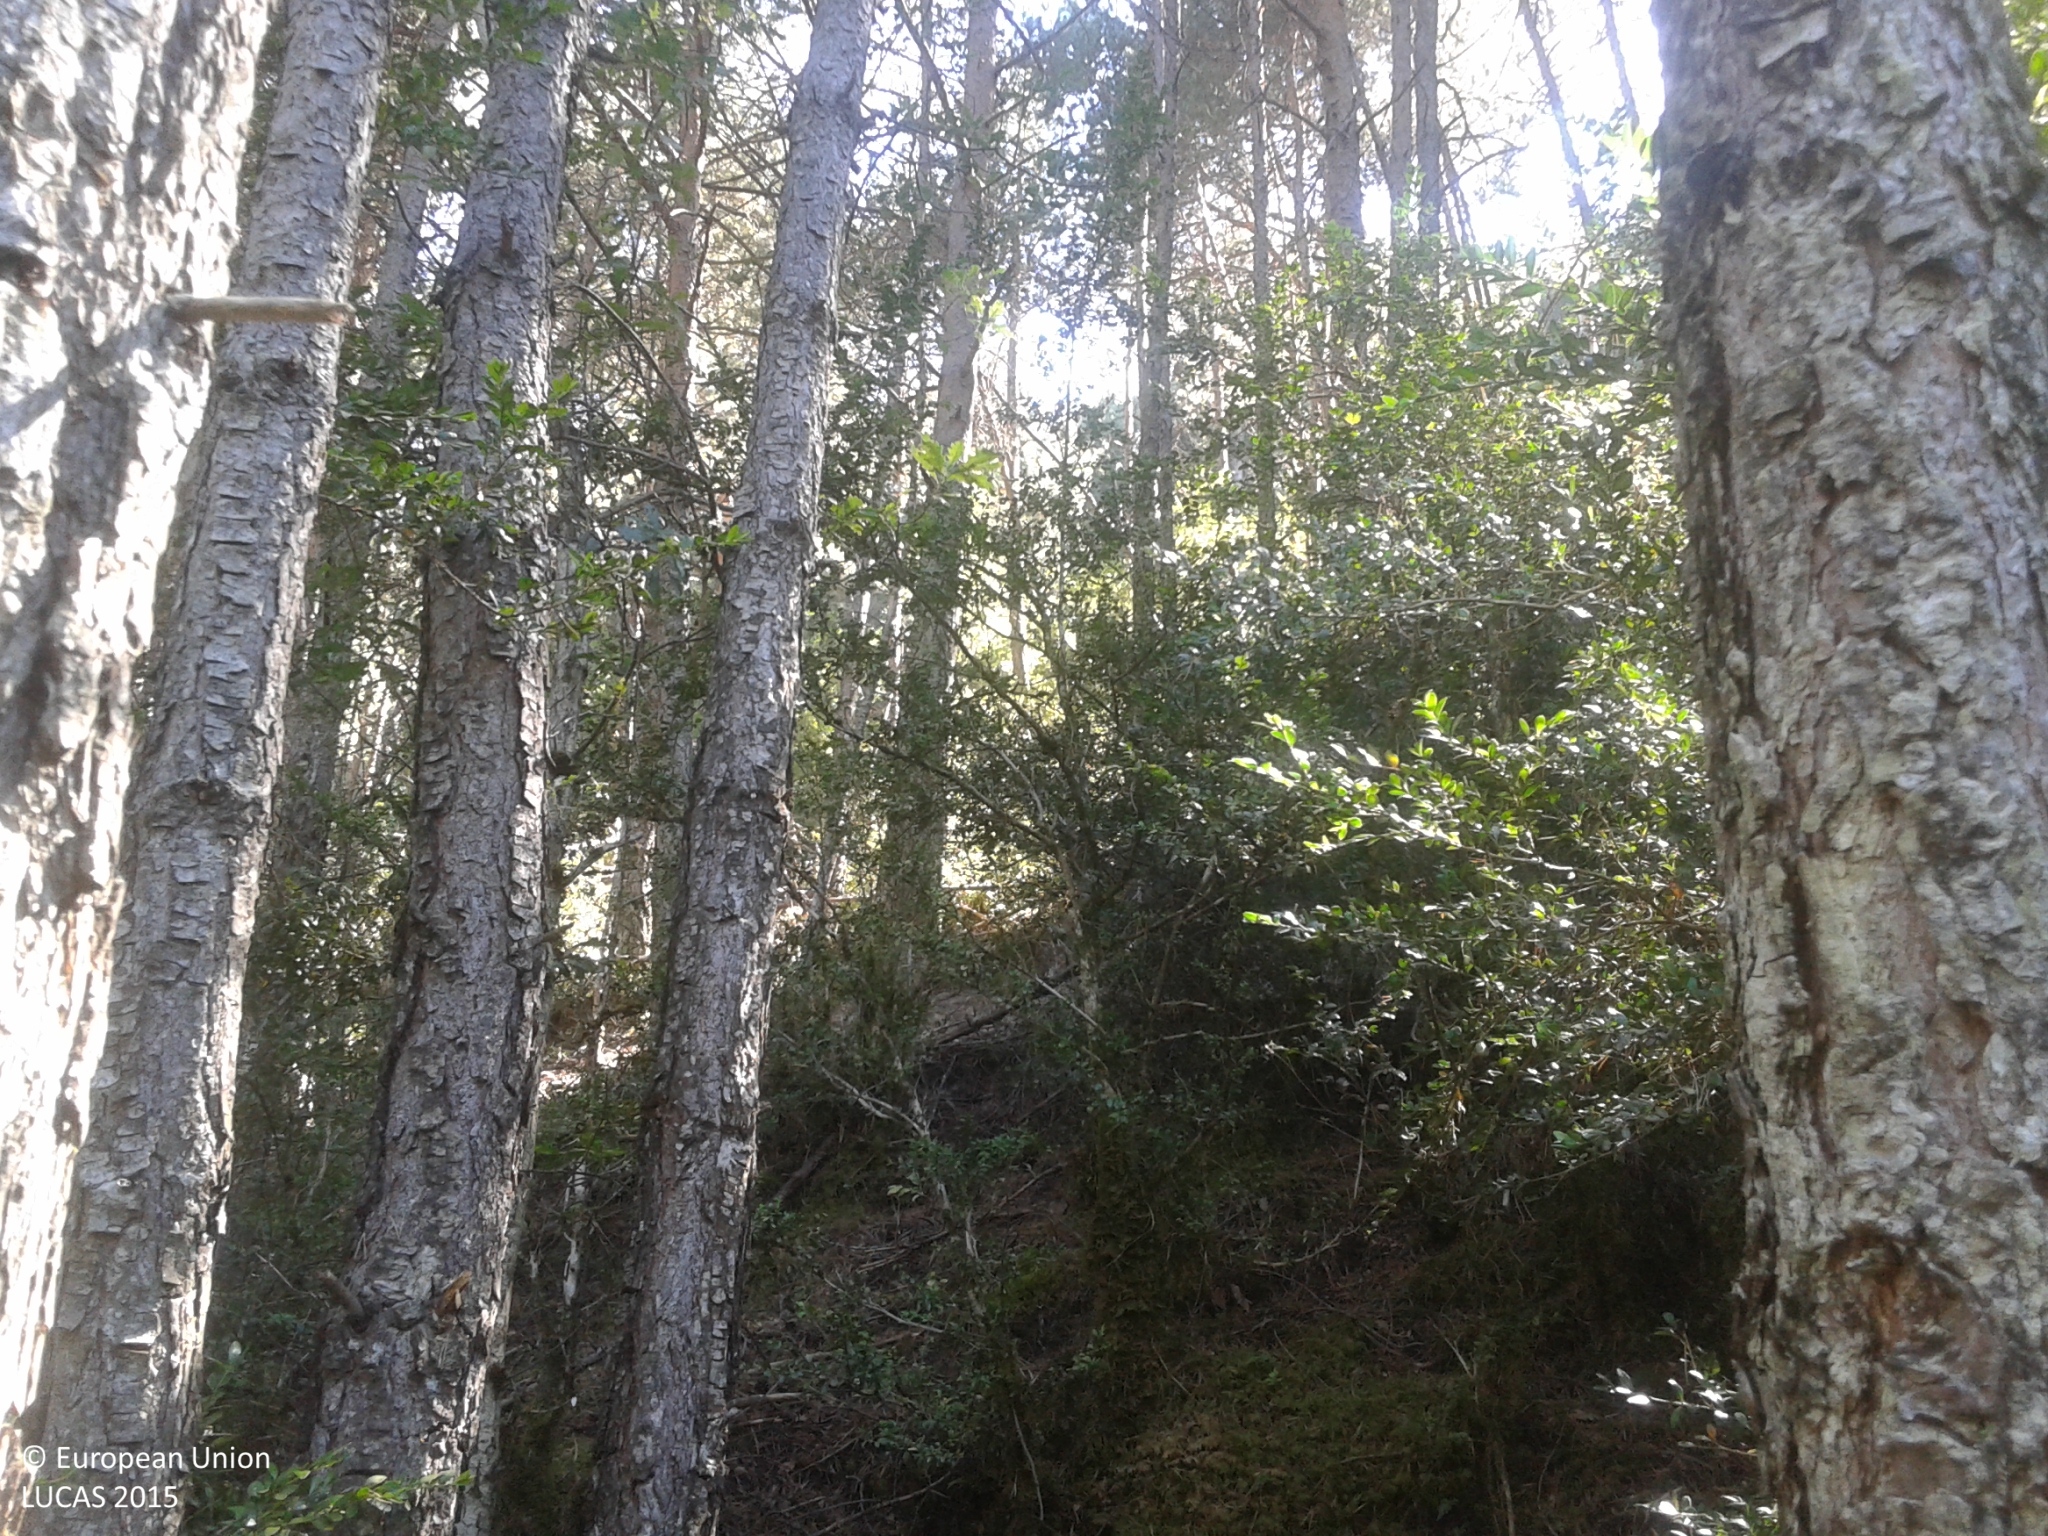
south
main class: Woodland
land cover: Pine dominated coniferous woodland
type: alpine coniferous forest
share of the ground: 50 - 75 %
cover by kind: coniferous forest trees 70 %, shrubs 30 %
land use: Semi-natural and natural areas not in use
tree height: > 5 m
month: July
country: ES
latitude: 42.3168
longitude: 1.5294
